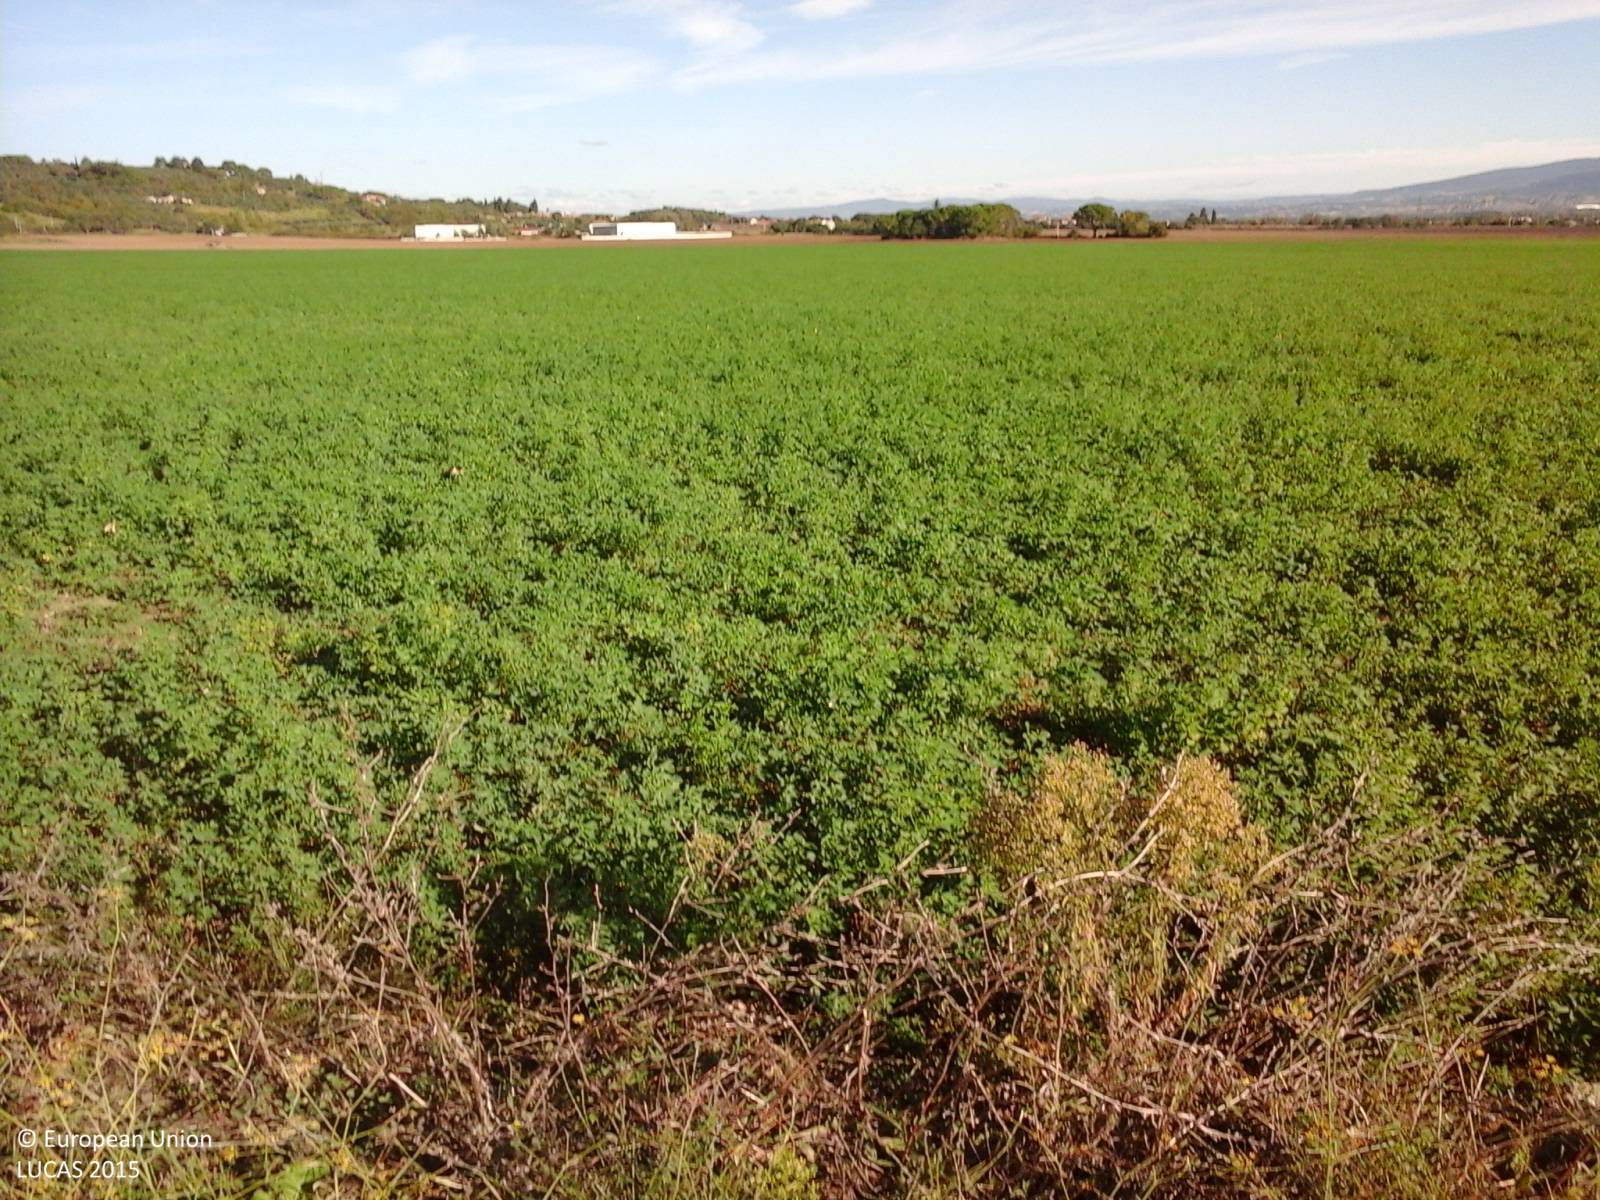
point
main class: Cropland
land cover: Lucerne
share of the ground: > 75 %
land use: Agriculture (excluding fallow land and kitchen gardens)
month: September
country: IT
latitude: 42.5388
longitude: 12.2451
